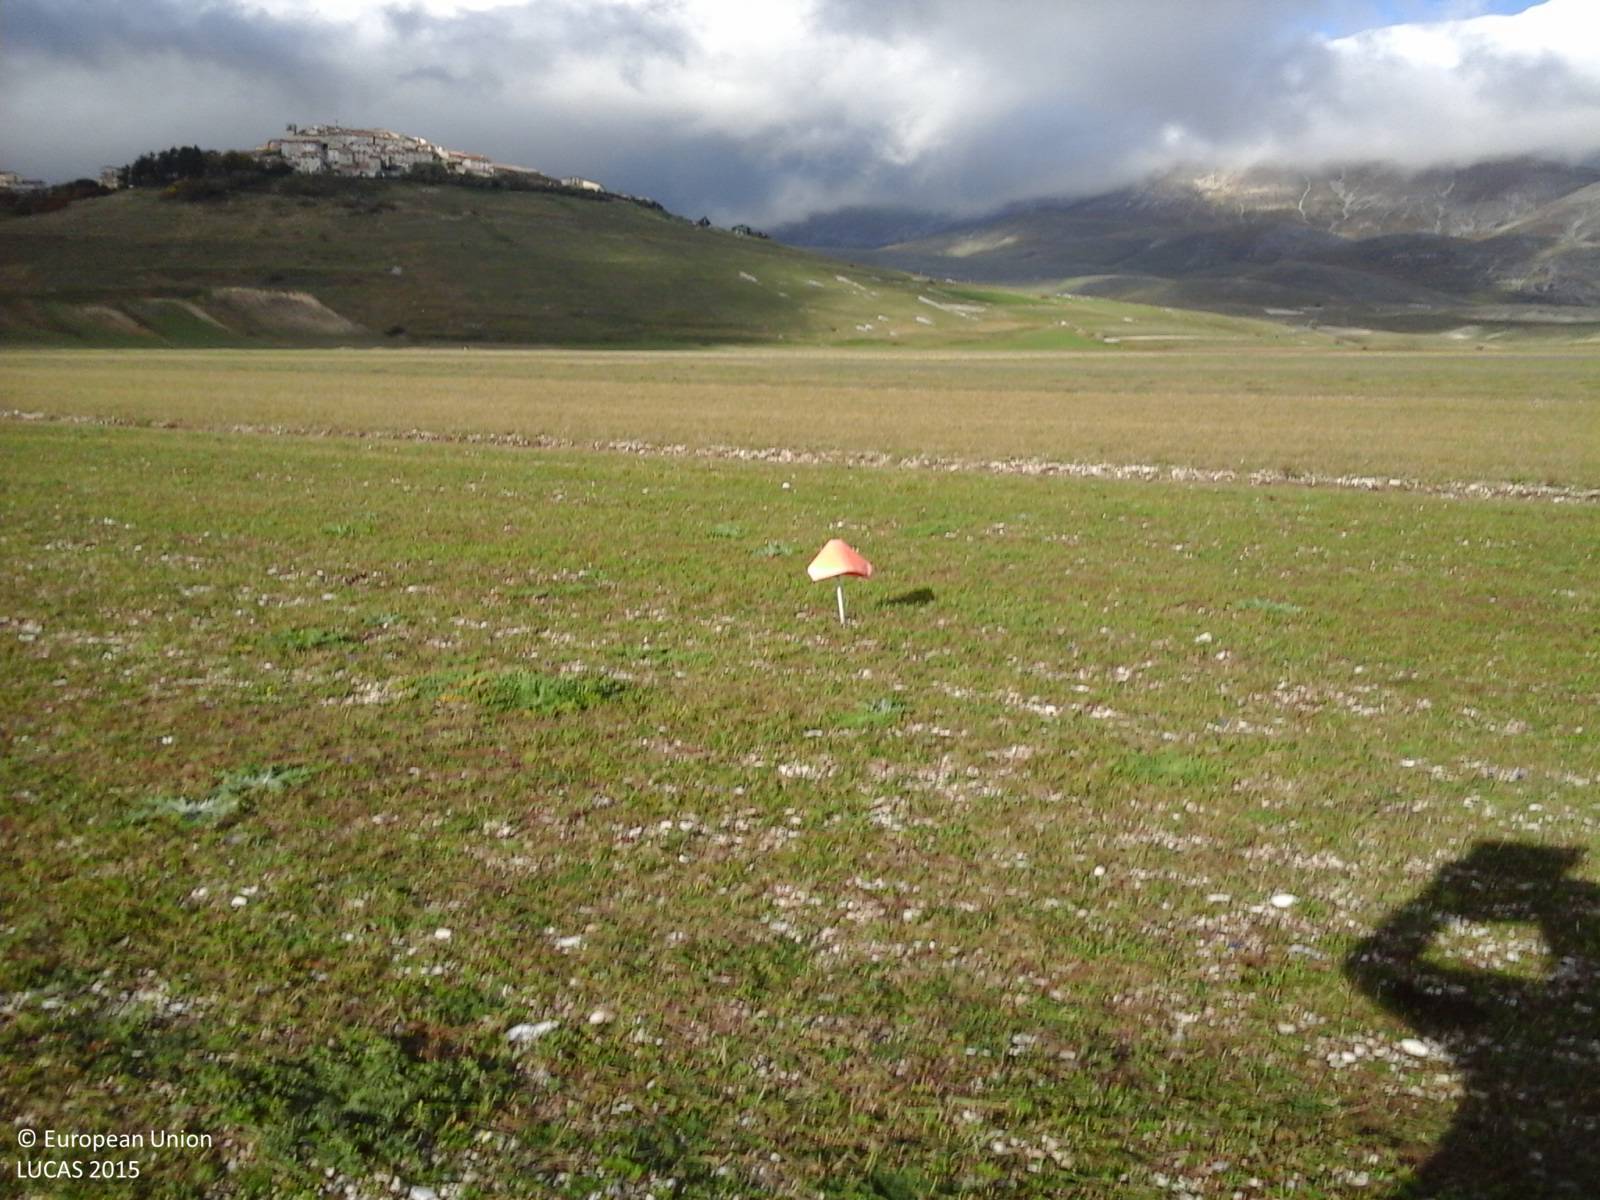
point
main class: Grassland
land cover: Grassland without tree/shrub cover
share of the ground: > 75 %
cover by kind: herbaceous plants 100 %
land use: Agriculture (excluding fallow land and kitchen gardens)
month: October
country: IT
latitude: 42.8201
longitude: 13.2074
